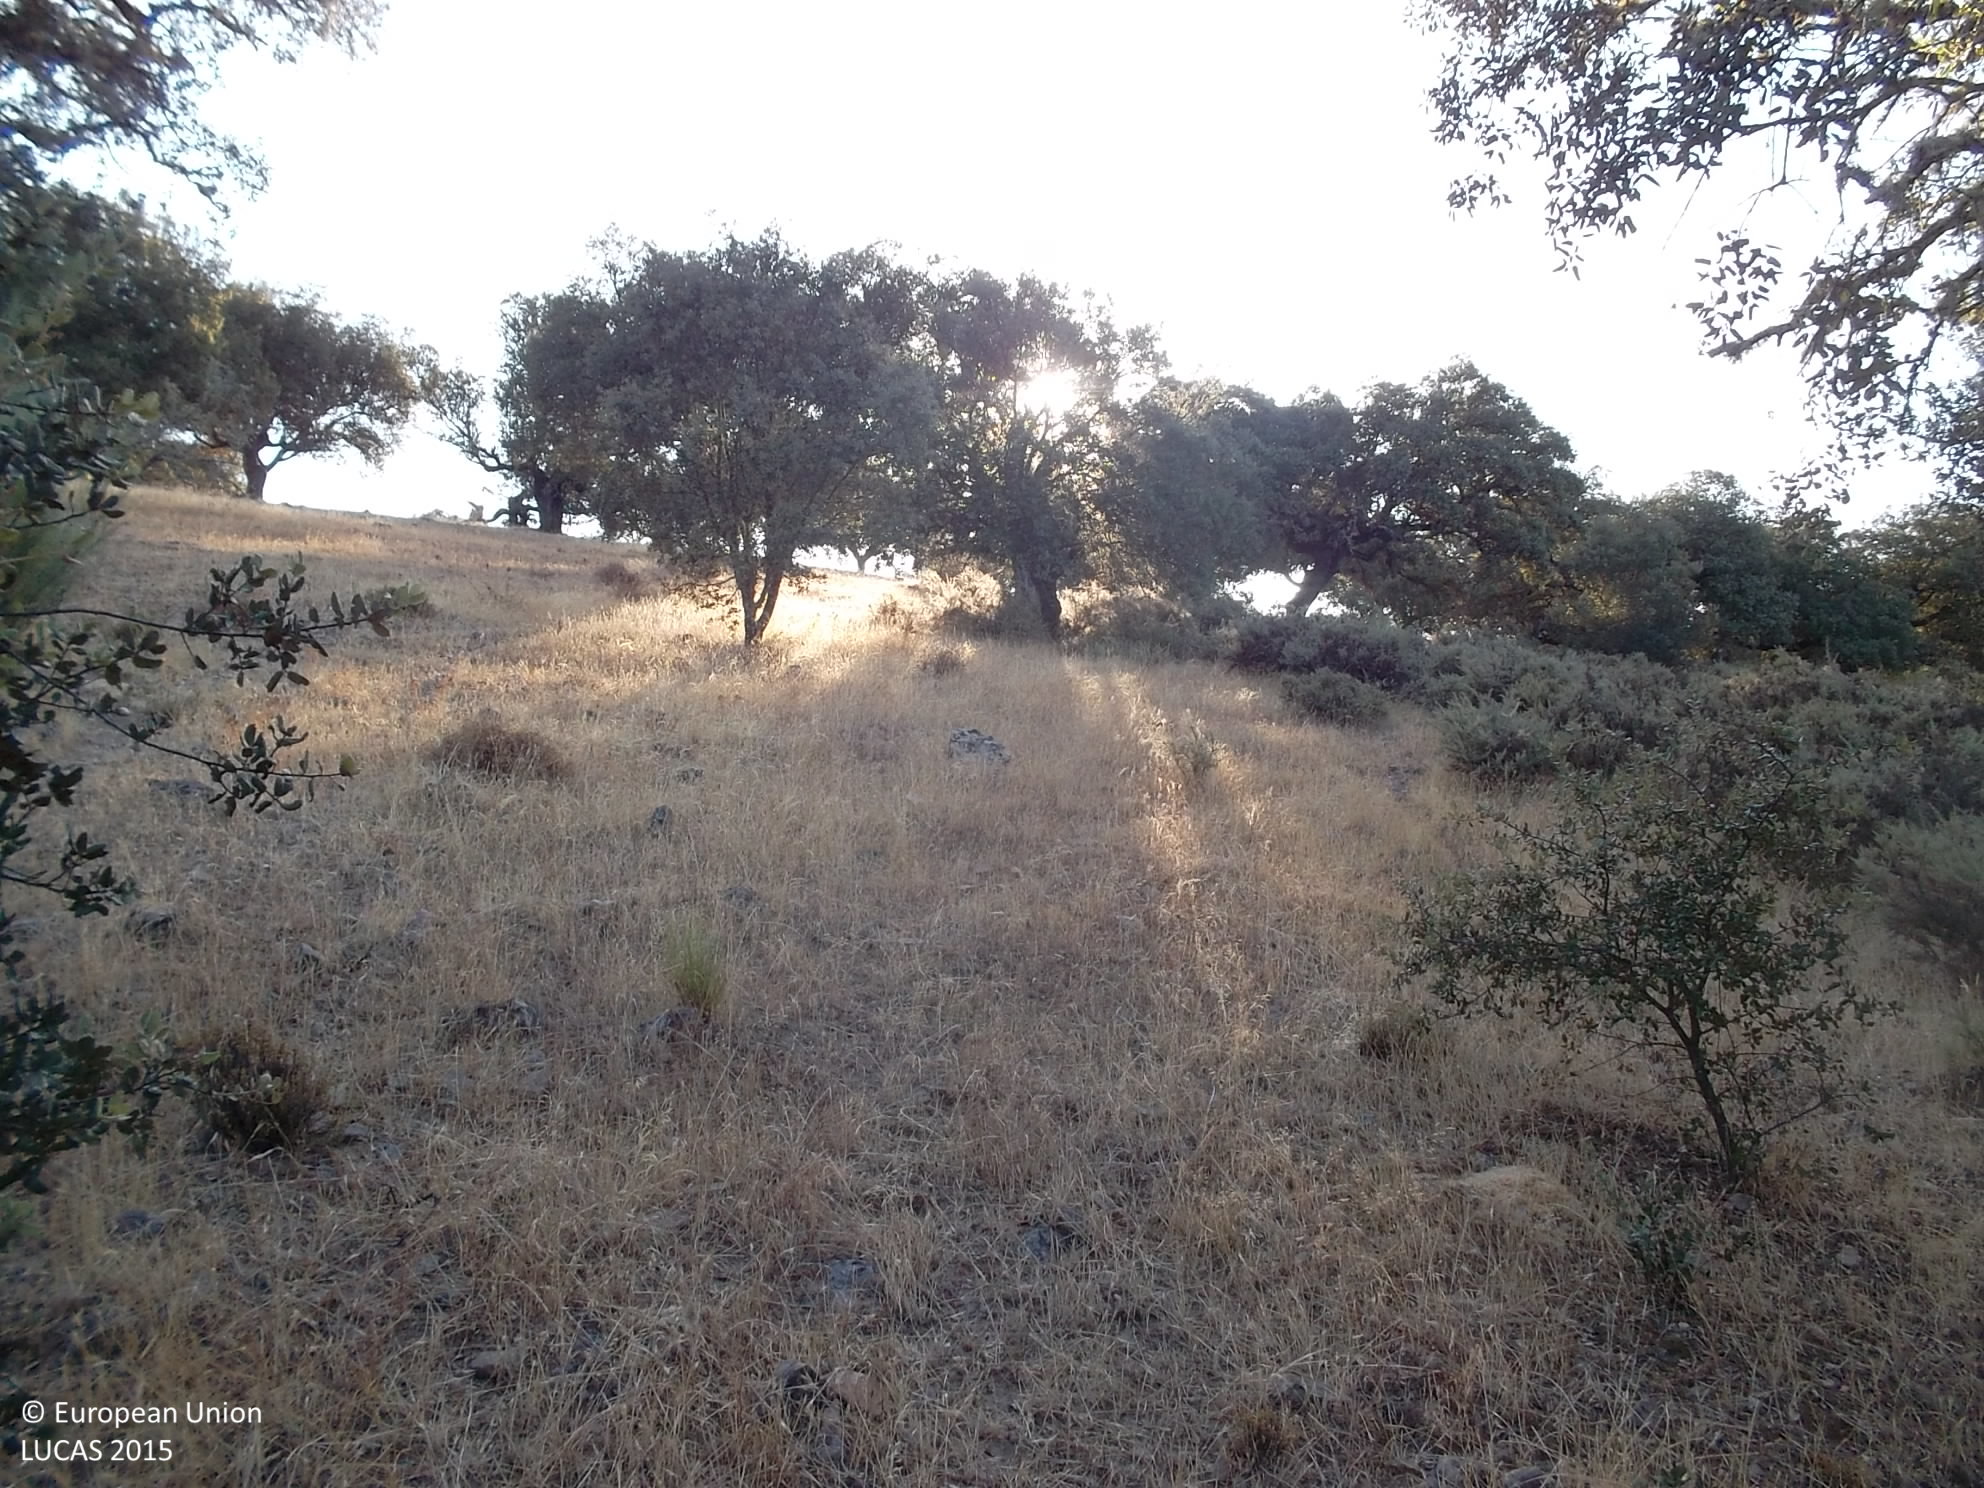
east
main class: Woodland
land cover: Broadleaved woodland
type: broadleaved evergreen forest
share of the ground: 50 - 75 %
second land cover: Grassland without tree/shrub cover
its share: > 75 %
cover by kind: broadleaved forest trees 50 %, herbaceous plants 50 %
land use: Forestry
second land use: Agriculture (excluding fallow land and kitchen gardens)
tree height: < 5 m
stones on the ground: 10 - 25 %
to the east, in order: Broadleaved woodland; Grassland without tree/shrub cover; Rivers and streams; Dry stone walls; Broadleaved woodland
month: August
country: ES
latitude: 38.1151
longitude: -6.6446
